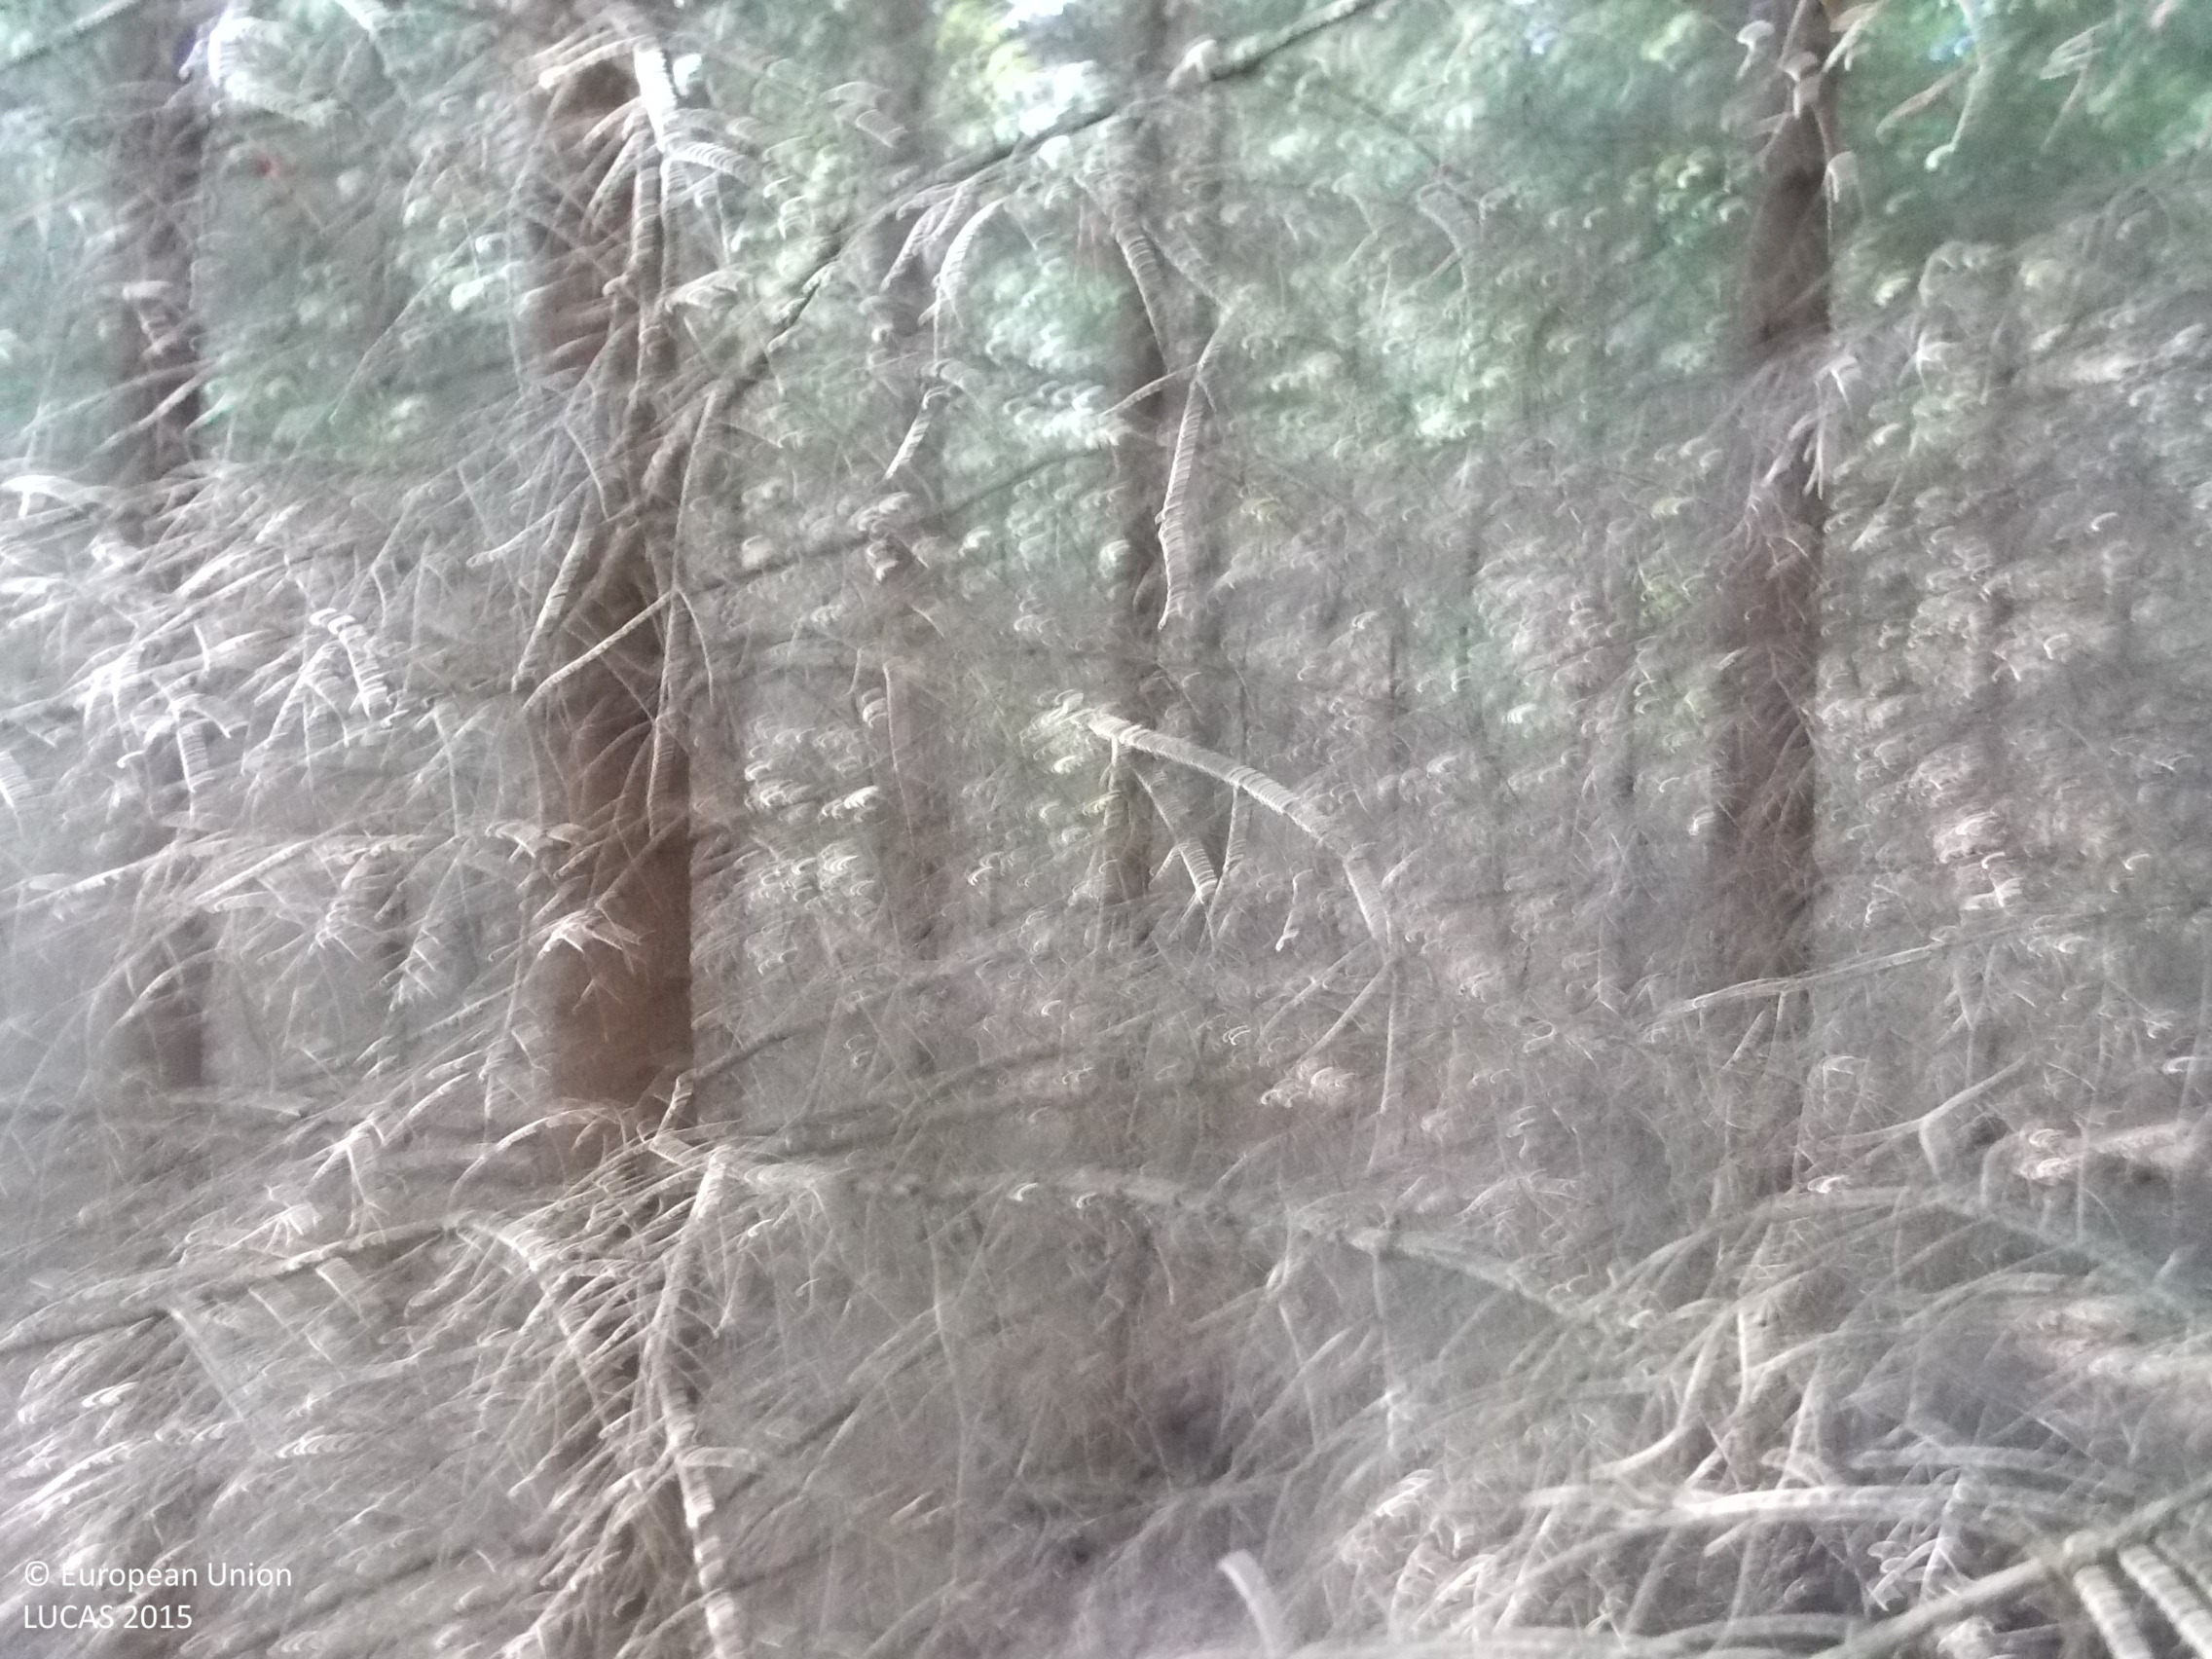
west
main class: Woodland
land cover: Spruce dominated coniferous woodland
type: boreal forest
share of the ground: > 75 %
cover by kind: coniferous forest trees 95 %, lichens and mosses 5 %
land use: Forestry
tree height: > 5 m
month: August
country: SE
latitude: 57.4823
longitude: 13.0814
